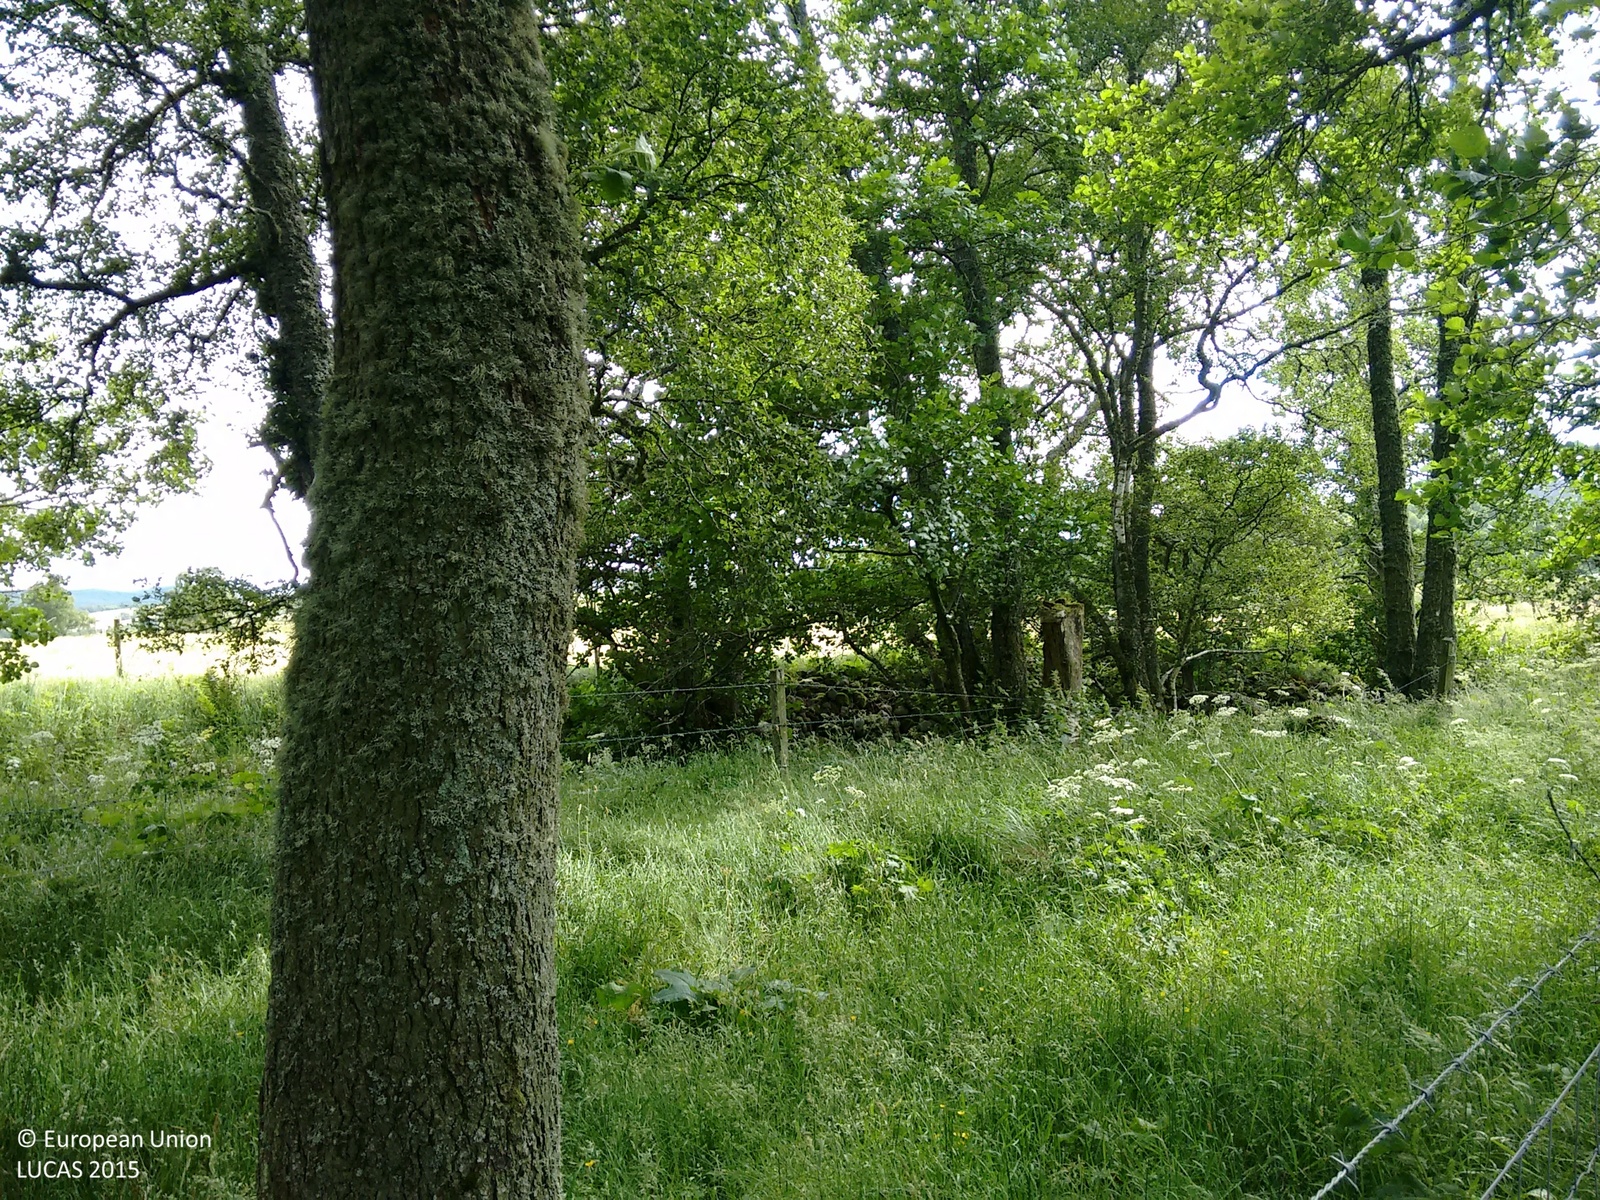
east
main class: Woodland
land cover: Broadleaved woodland
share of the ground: > 75 %
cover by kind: broadleaved forest trees 100 %
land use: Agriculture (excluding fallow land and kitchen gardens)
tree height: > 5 m
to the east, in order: Broadleaved woodland; Fences; Grassland without tree/shrub cover; Fences; Grassland without tree/shrub cover
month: August
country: GB
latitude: 57.4105
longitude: -4.1502
